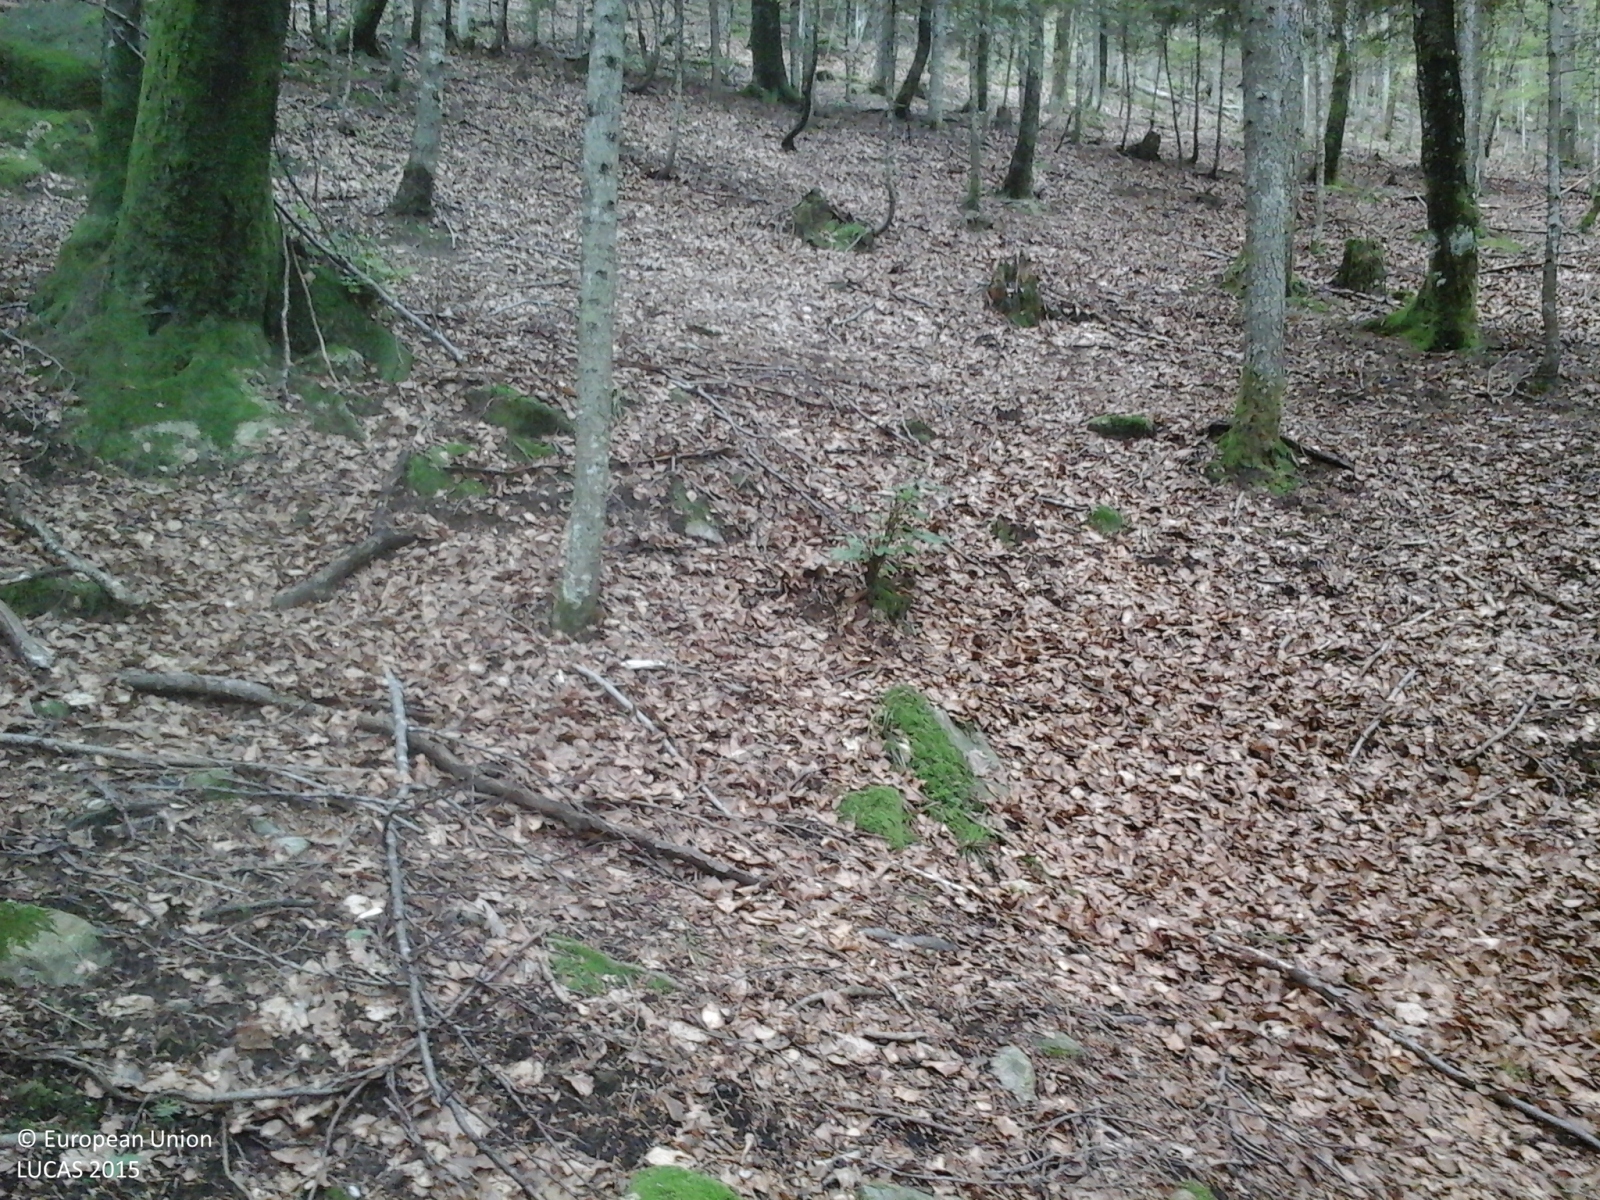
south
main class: Woodland
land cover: Other mixed woodland
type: mountainous beech forest
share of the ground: > 75 %
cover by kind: broadleaved forest trees 75 %, coniferous forest trees 25 %
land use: Forestry
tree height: > 5 m
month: June
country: IT
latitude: 46.1236
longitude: 8.4362
